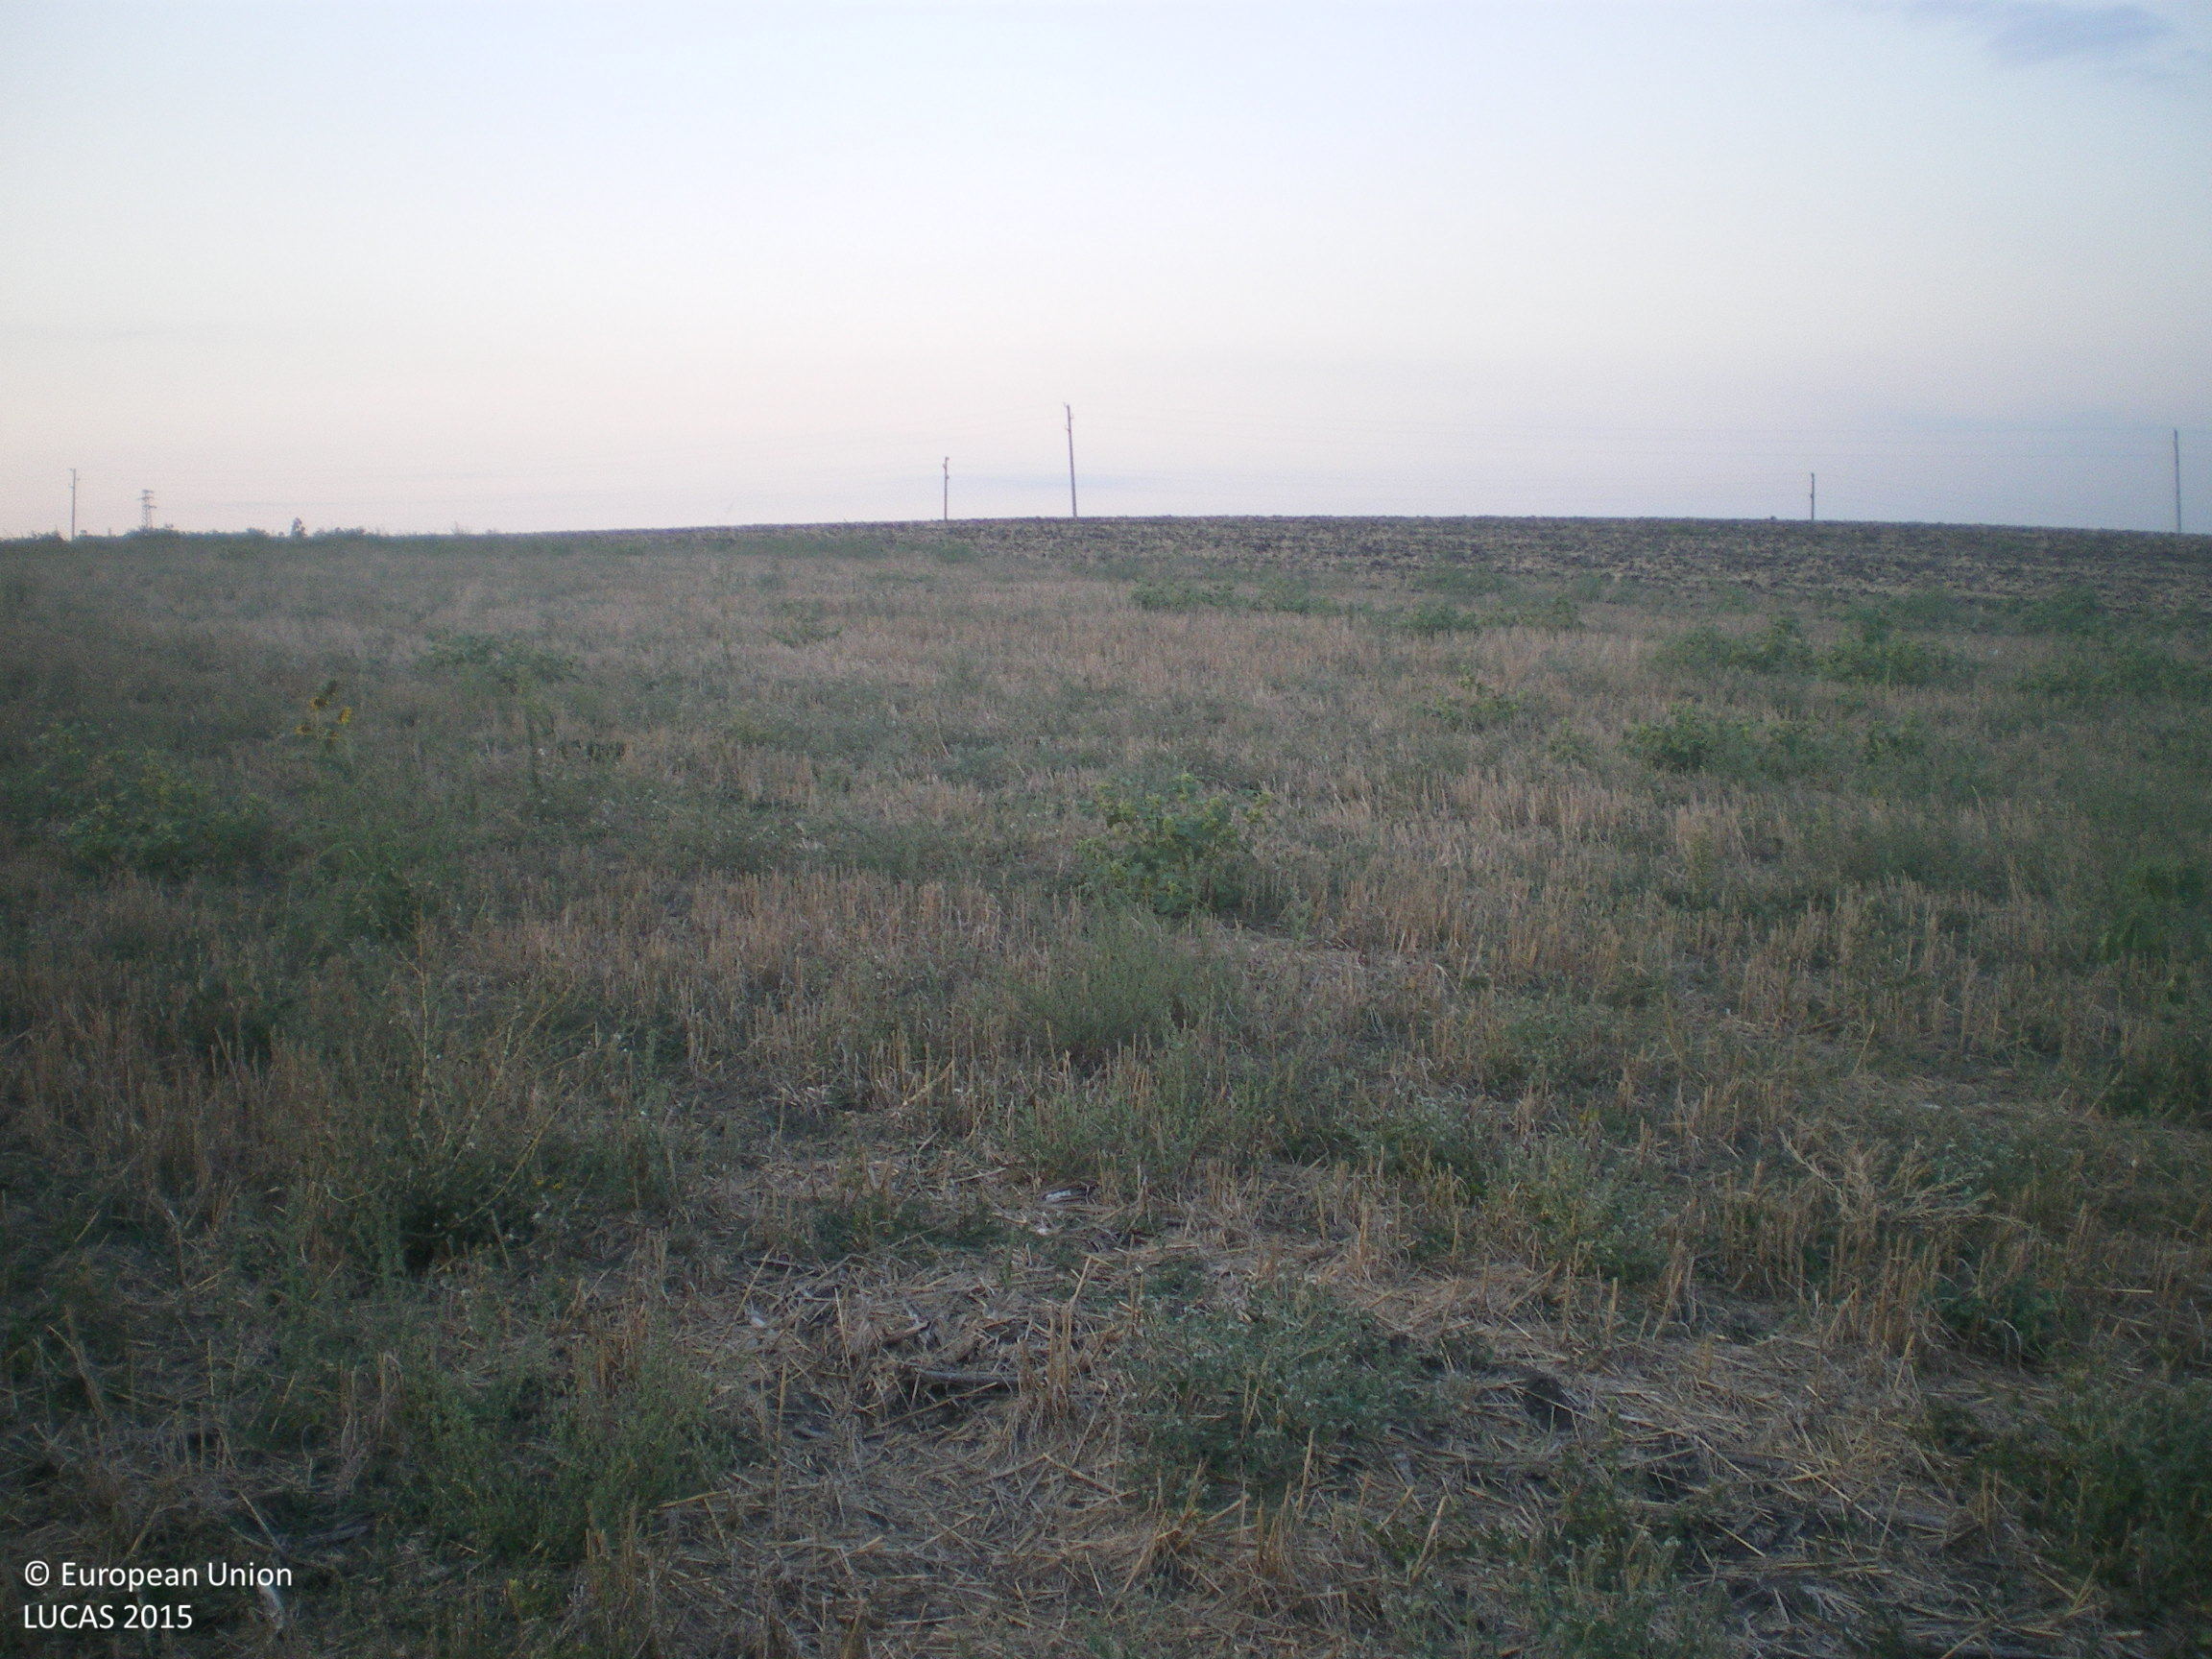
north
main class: Cropland
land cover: Common wheat
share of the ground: < 10 %
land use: Agriculture (excluding fallow land and kitchen gardens)
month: September
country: BG
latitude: 42.1299
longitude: 25.8603
